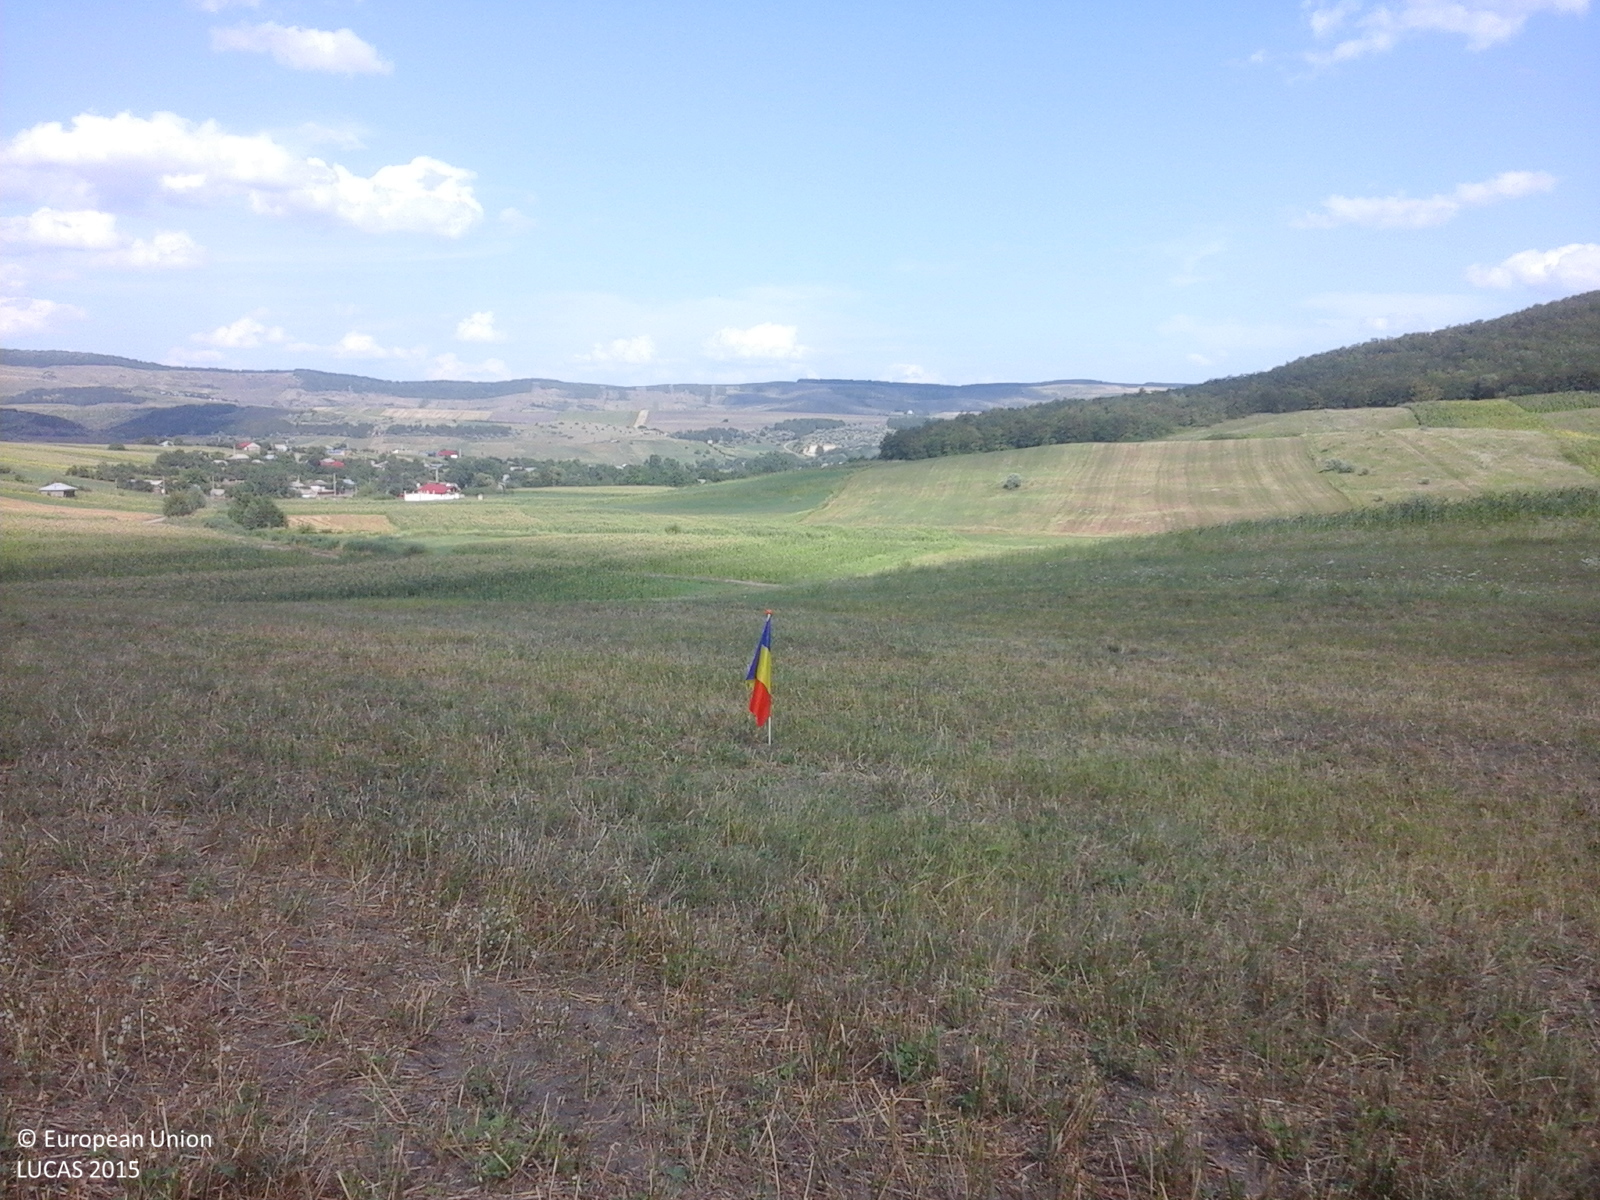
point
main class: Cropland
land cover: Lucerne
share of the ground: > 75 %
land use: Agriculture (excluding fallow land and kitchen gardens)
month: July
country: RO
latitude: 46.5943
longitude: 27.3497
